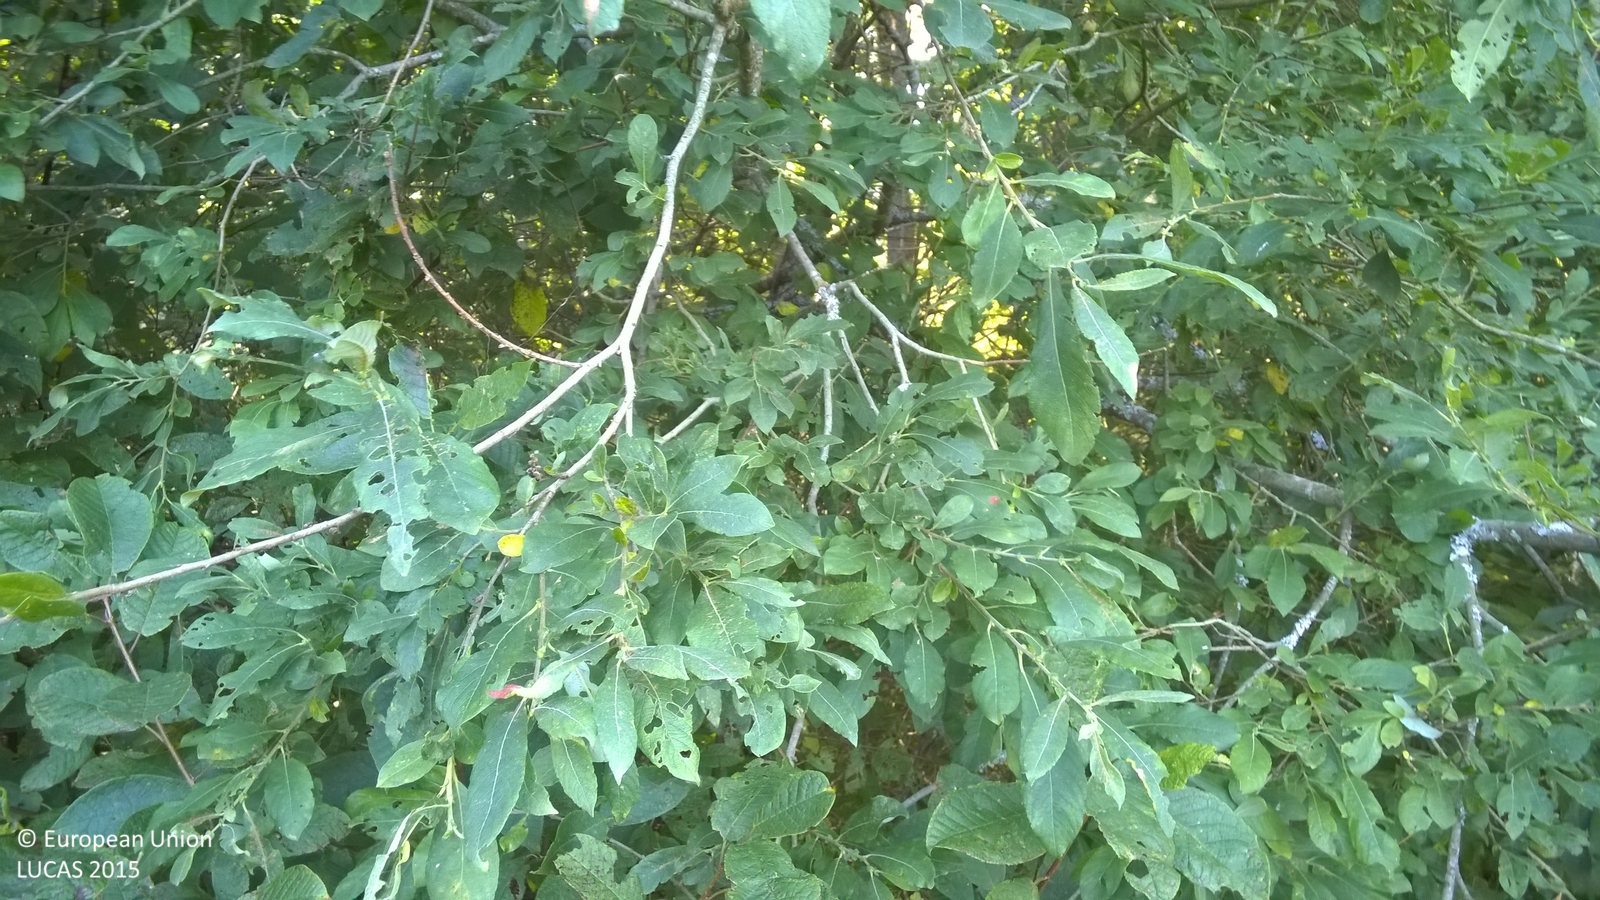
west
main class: Woodland
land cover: Broadleaved woodland
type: non-riverine alder, birch or aspen forest
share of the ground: > 75 %
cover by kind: broadleaved forest trees 90 %, shrubs 5 %, herbaceous plants 5 %
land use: Forestry
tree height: > 5 m
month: August
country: LV
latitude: 57.2899
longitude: 25.5309
